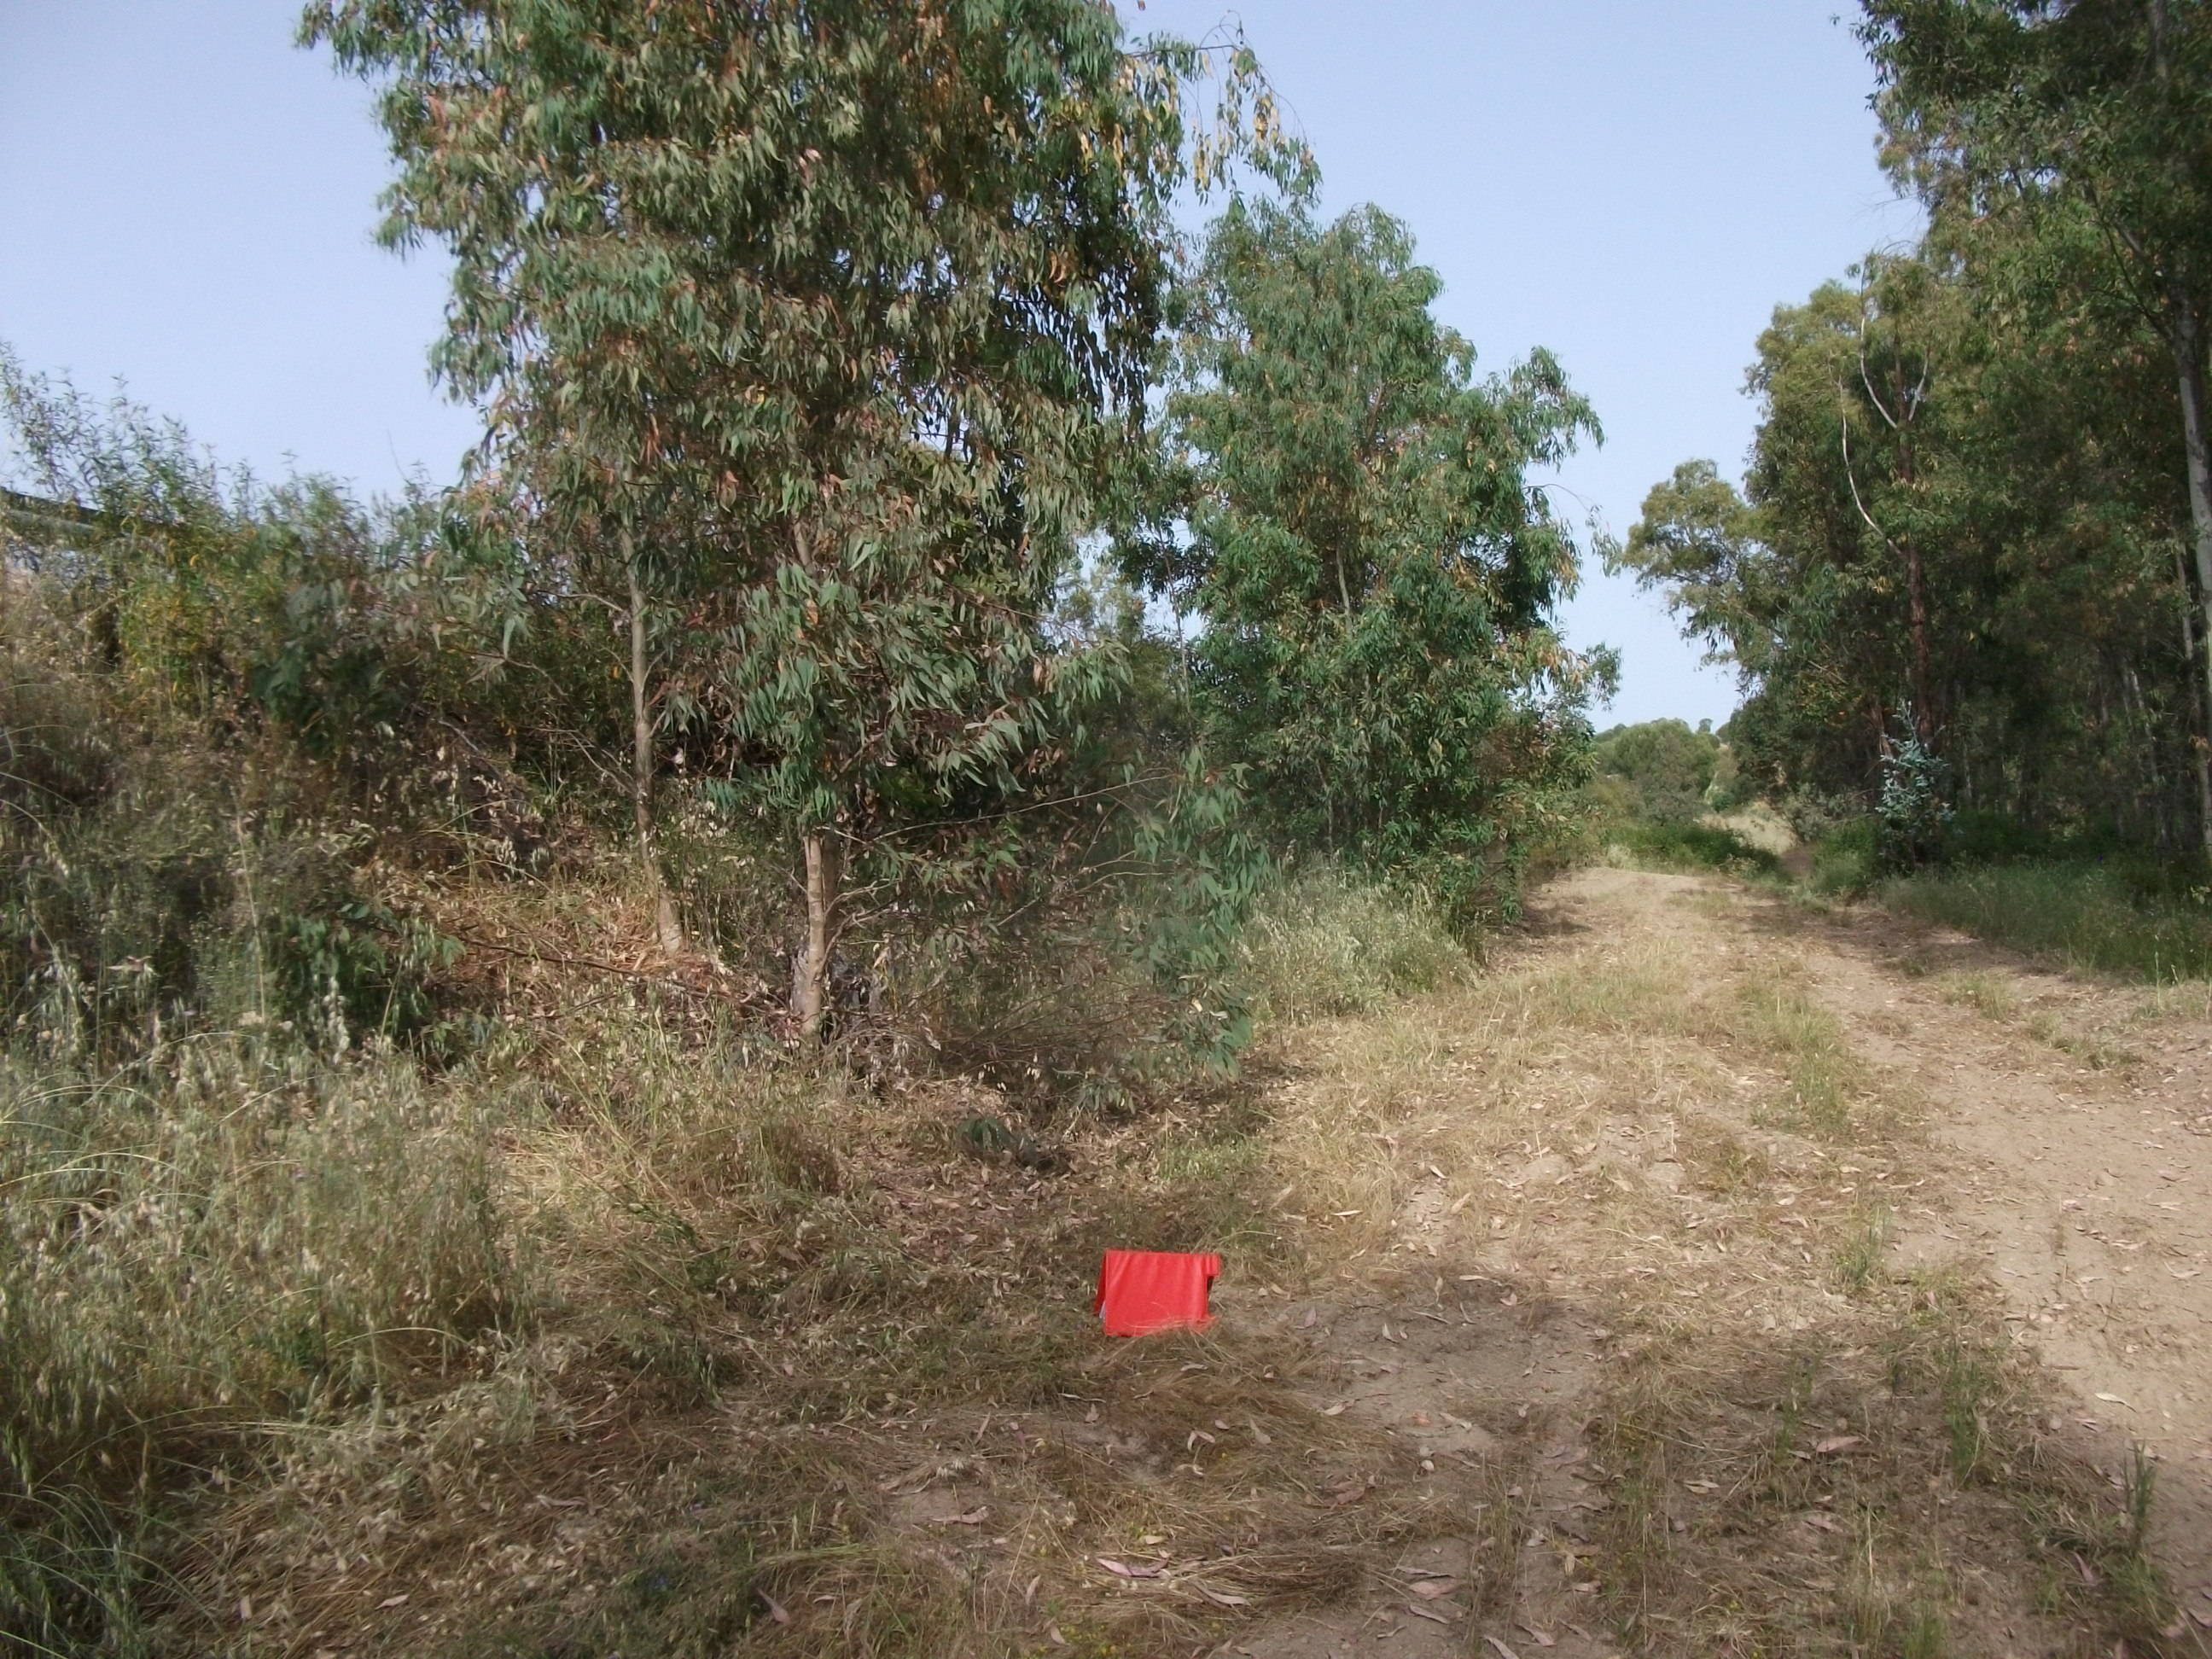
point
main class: Woodland
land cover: Broadleaved woodland
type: exotic forest
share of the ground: 10 - 25 %
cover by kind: herbaceous plants 80 %, broadleaved forest trees 20 %
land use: Semi-natural and natural areas not in use
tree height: > 5 m
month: May
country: ES
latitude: 37.6906
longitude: -6.9557
